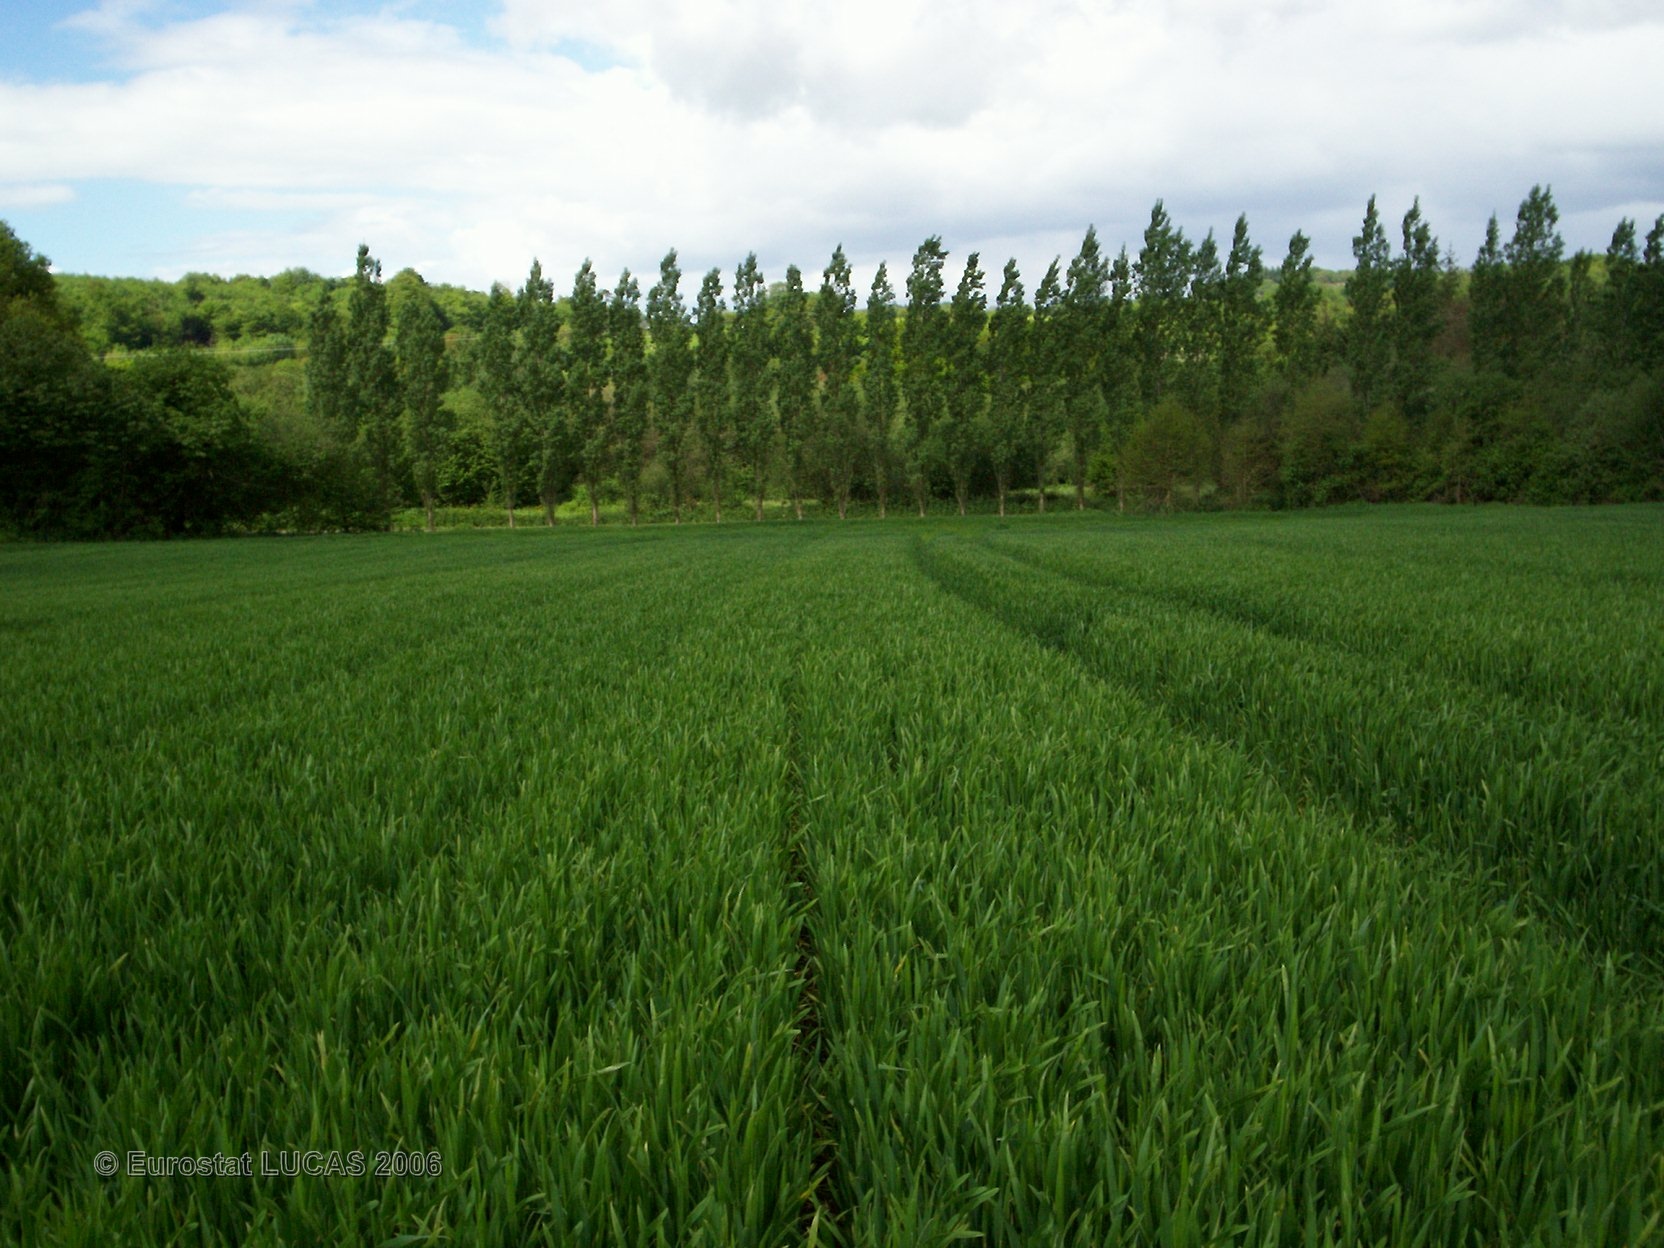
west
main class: Cropland
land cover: Common wheat
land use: Agriculture (excluding fallow land and kitchen gardens)
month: May
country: FR
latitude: 48.2951
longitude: -2.9410
